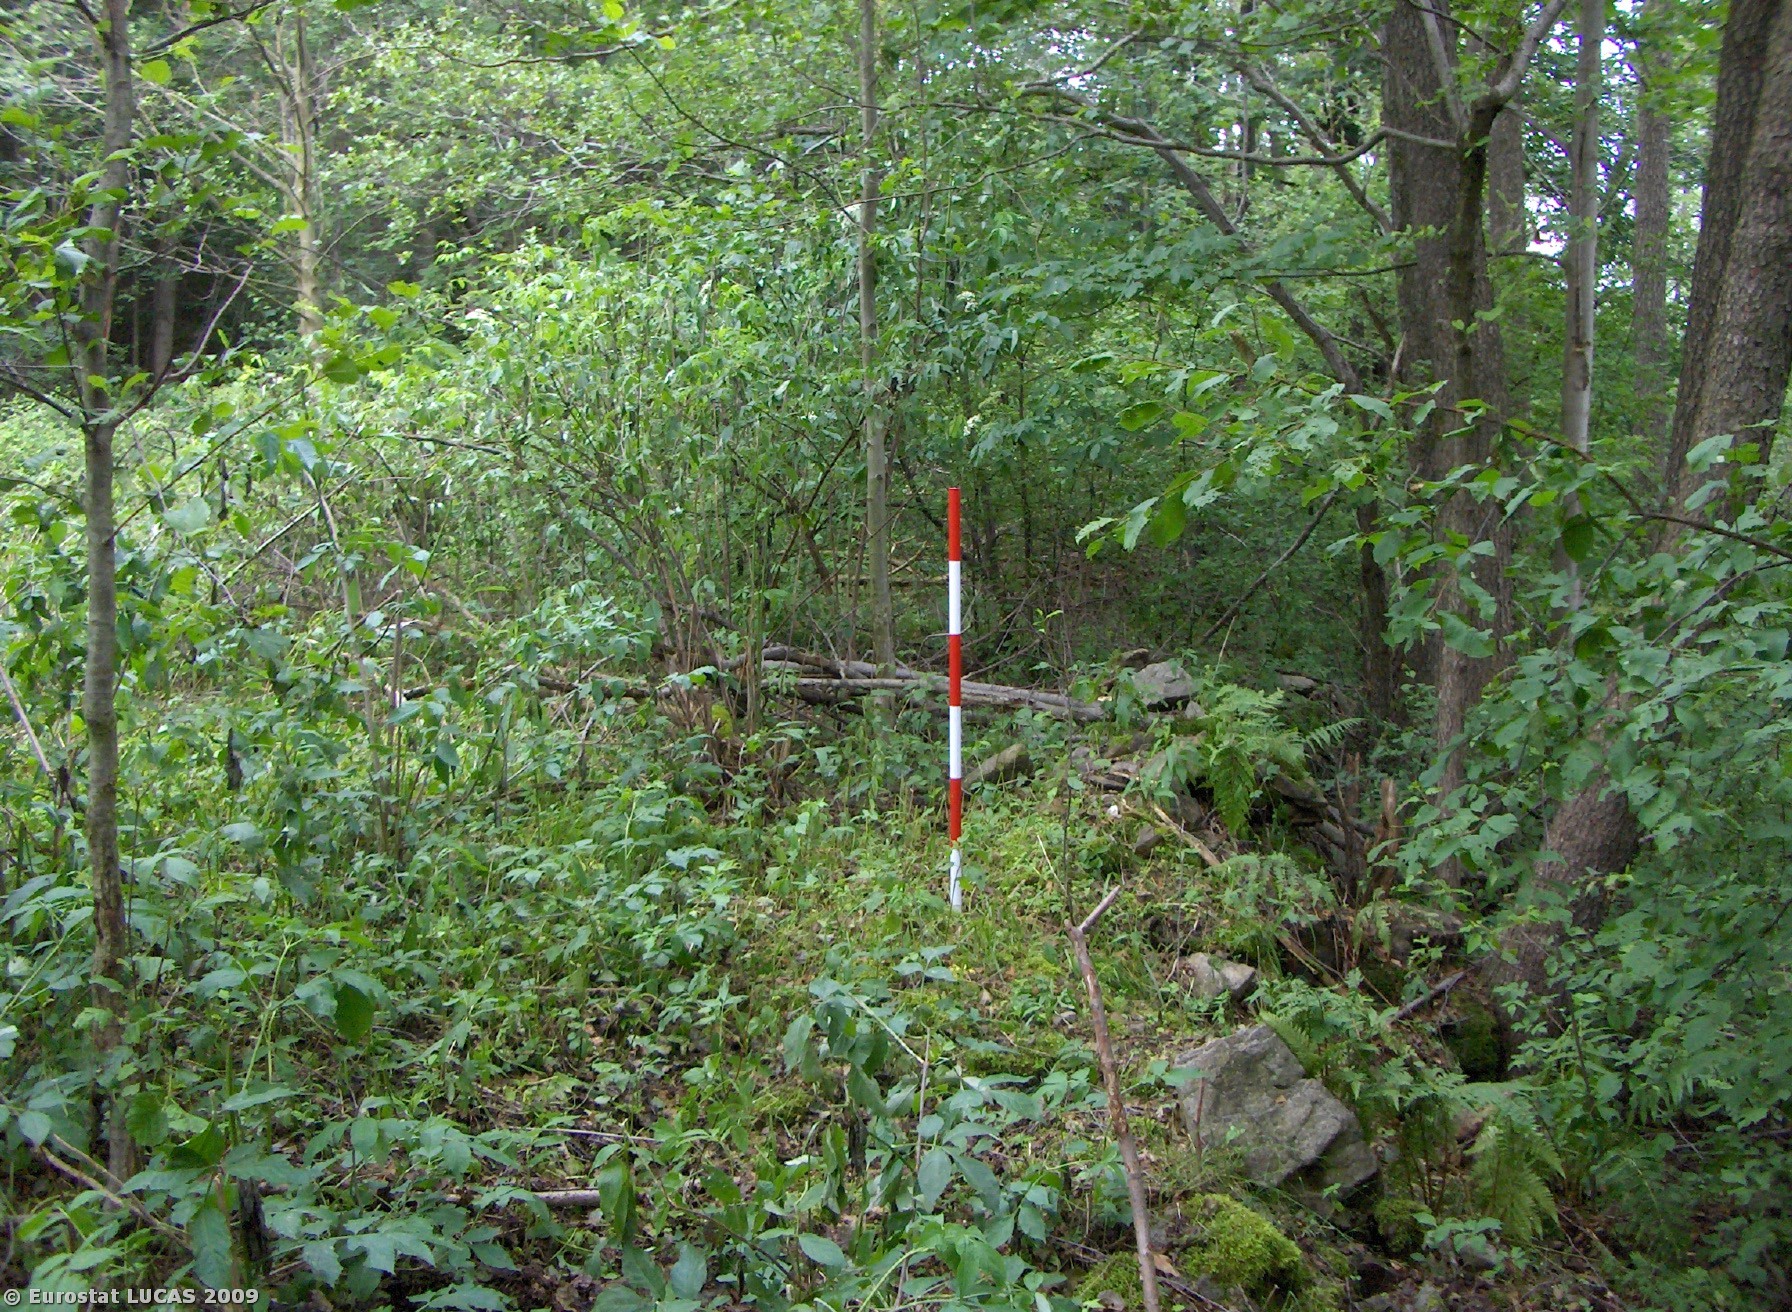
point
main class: Woodland
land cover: Broadleaved woodland
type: non-riverine alder, birch or aspen forest
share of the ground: > 75 %
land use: Forestry
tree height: > 5 m
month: June
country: CZ
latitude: 48.9755
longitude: 14.1128
